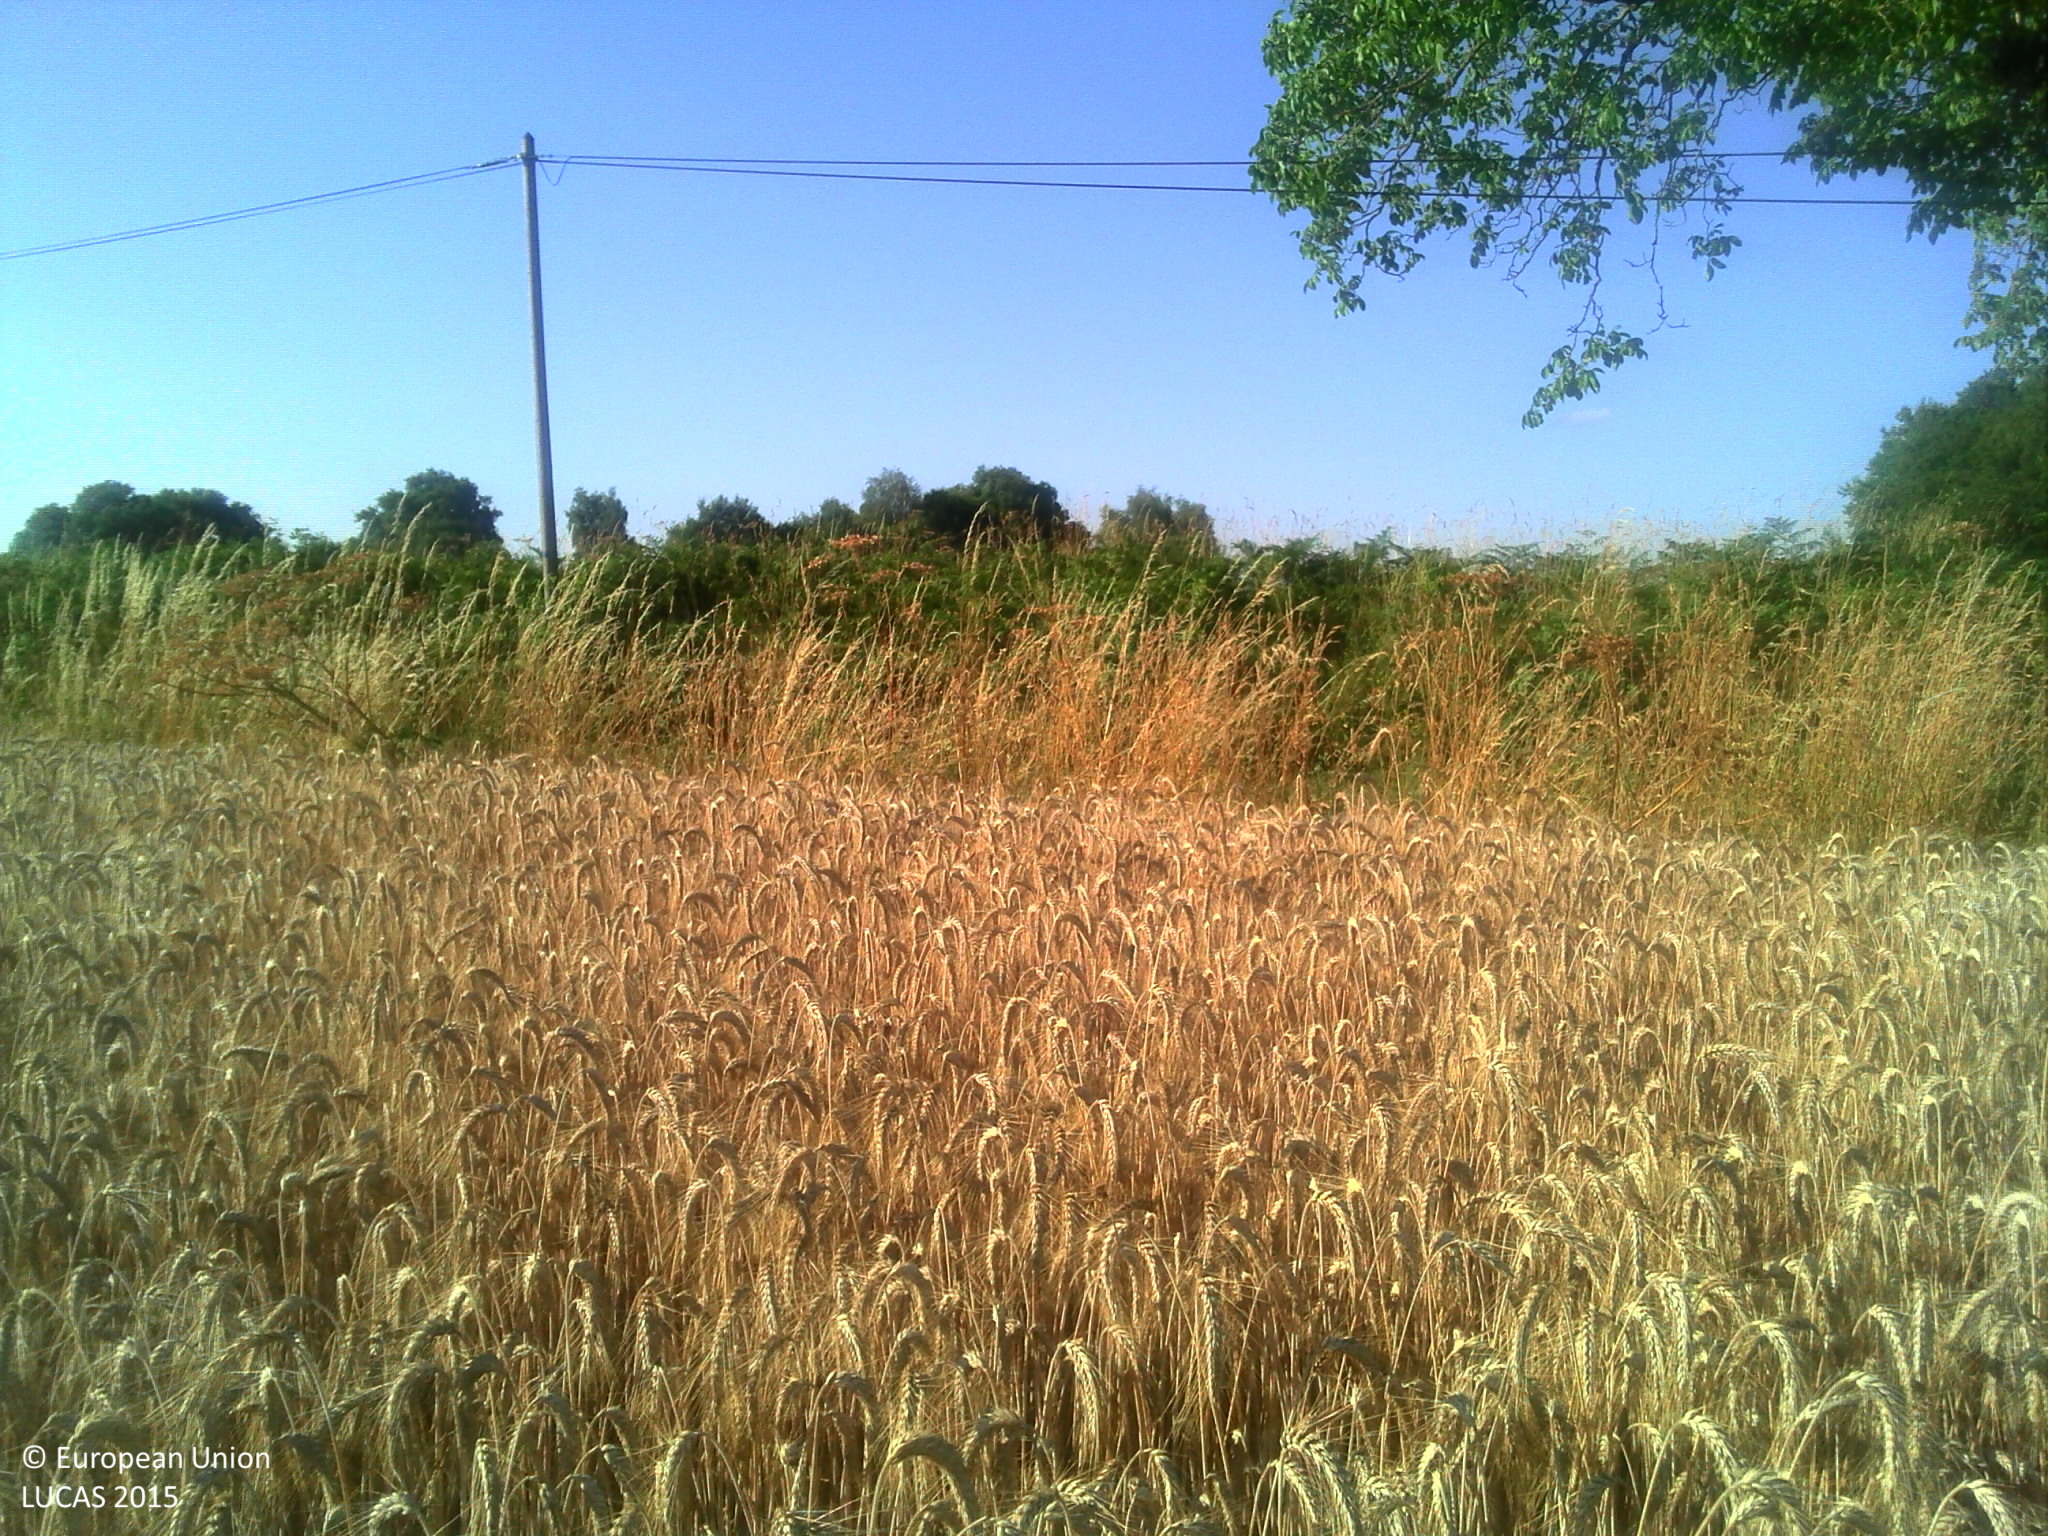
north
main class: Cropland
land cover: Common wheat
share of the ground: > 75 %
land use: Agriculture (excluding fallow land and kitchen gardens)
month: July
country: FR
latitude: 46.2357
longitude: 1.5752
